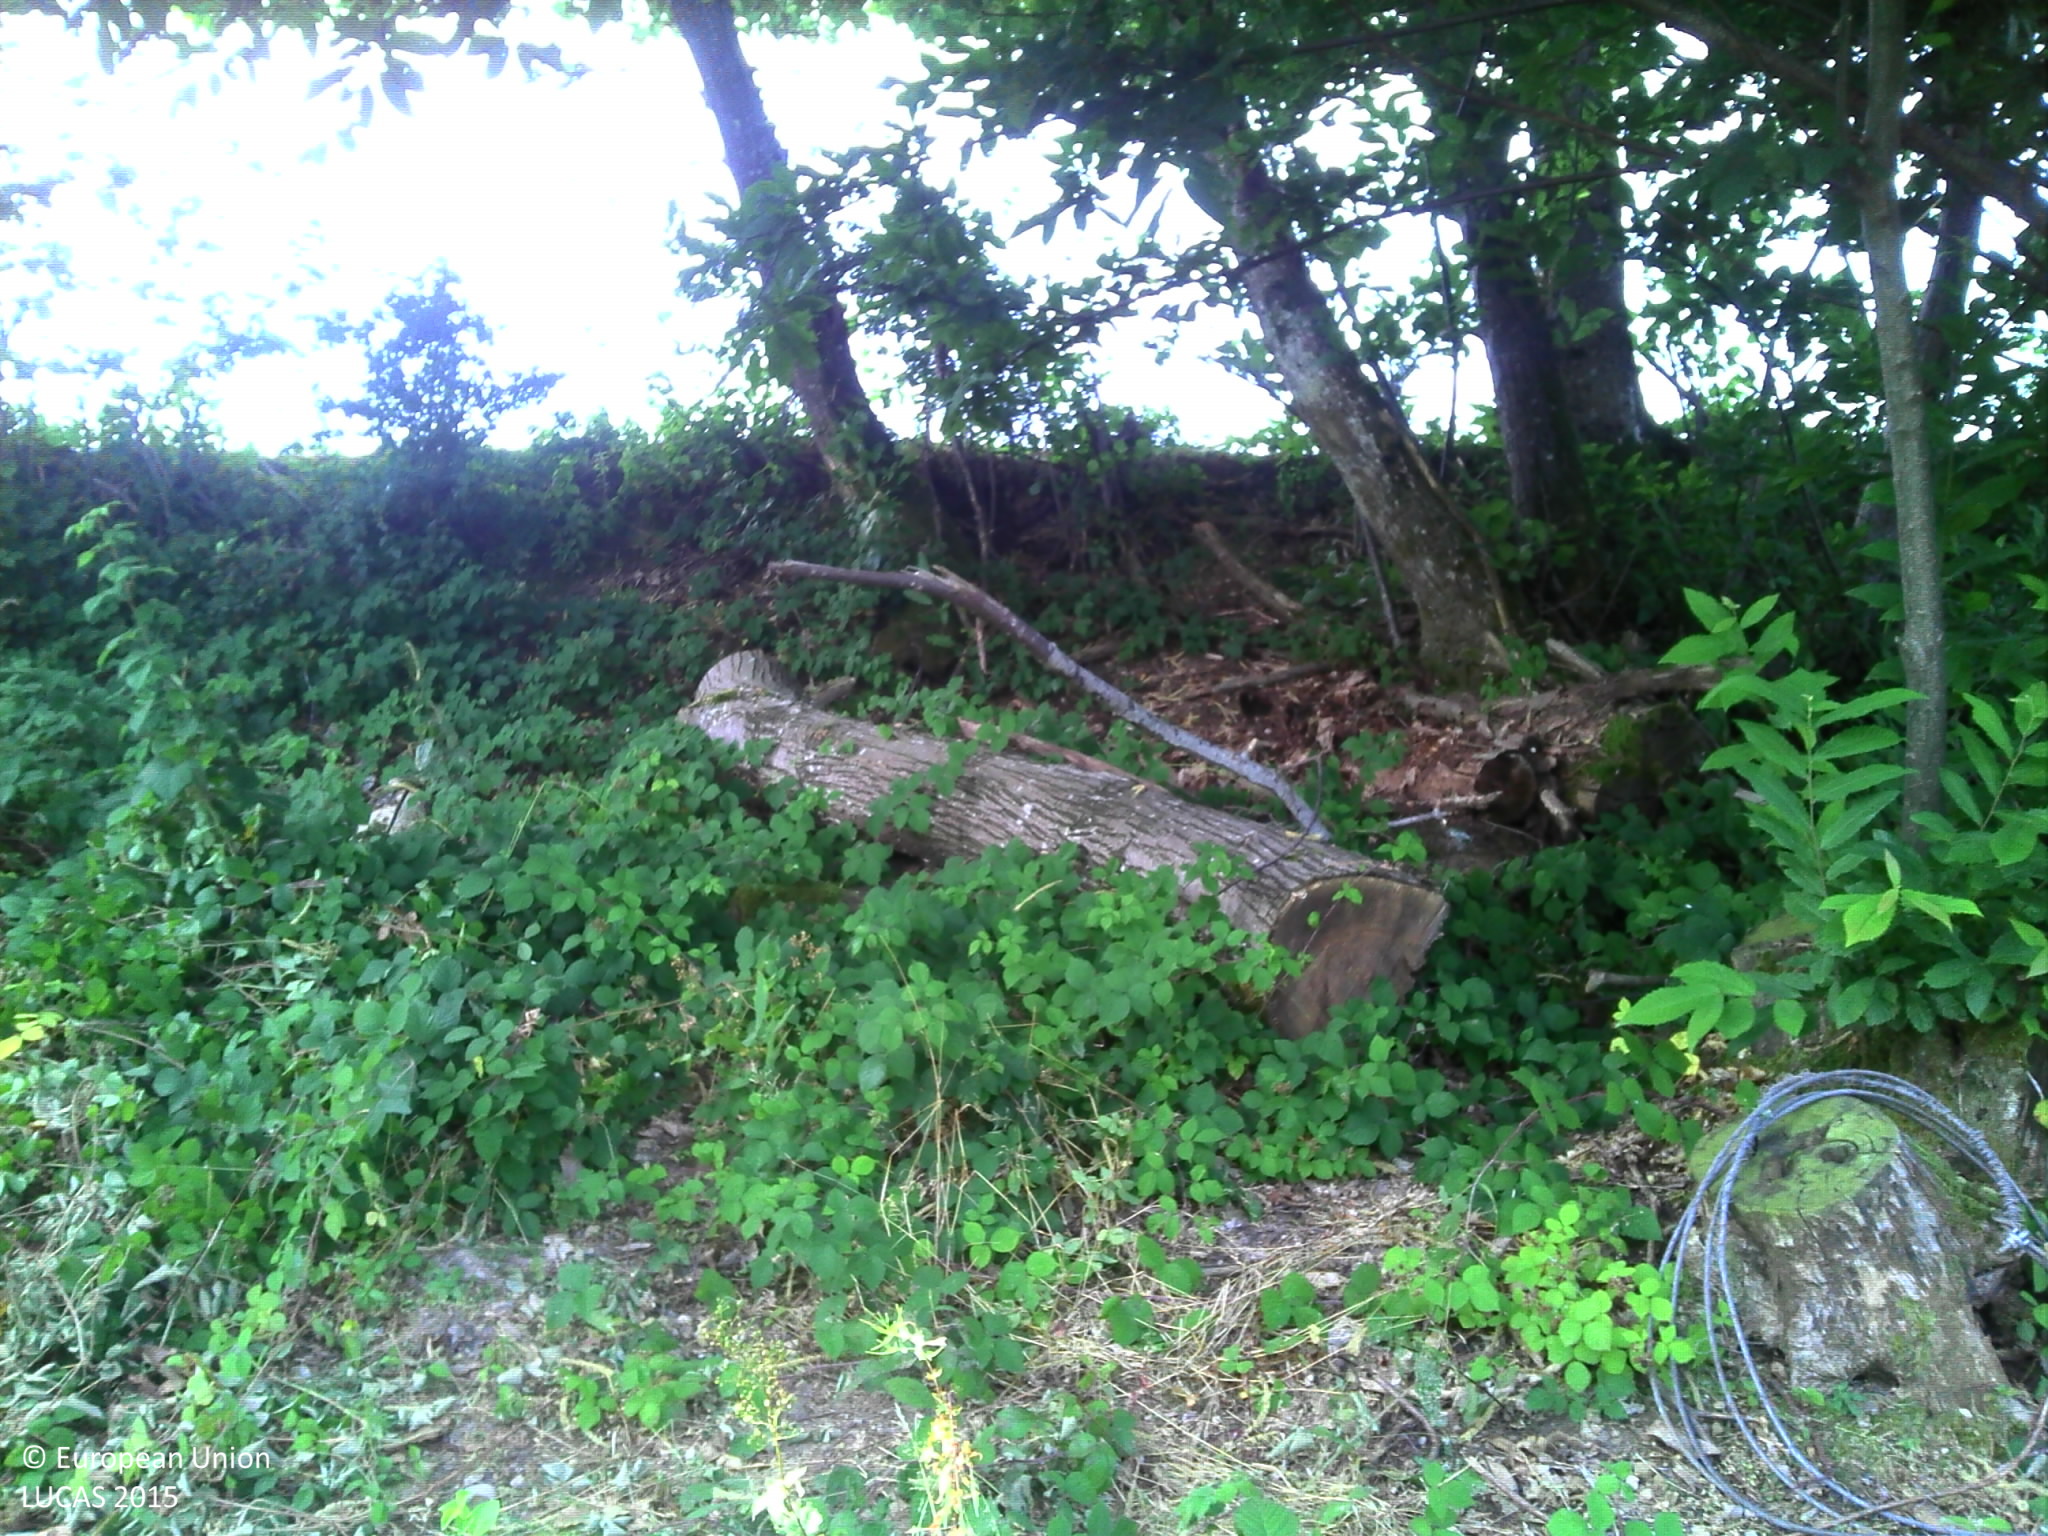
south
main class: Woodland
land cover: Broadleaved woodland
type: floodplain forest
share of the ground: > 75 %
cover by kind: broadleaved forest trees 50 %, herbaceous plants 50 %
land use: Forestry
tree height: > 5 m
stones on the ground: 10 - 25 %
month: July
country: FR
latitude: 45.4960
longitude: 5.4362
